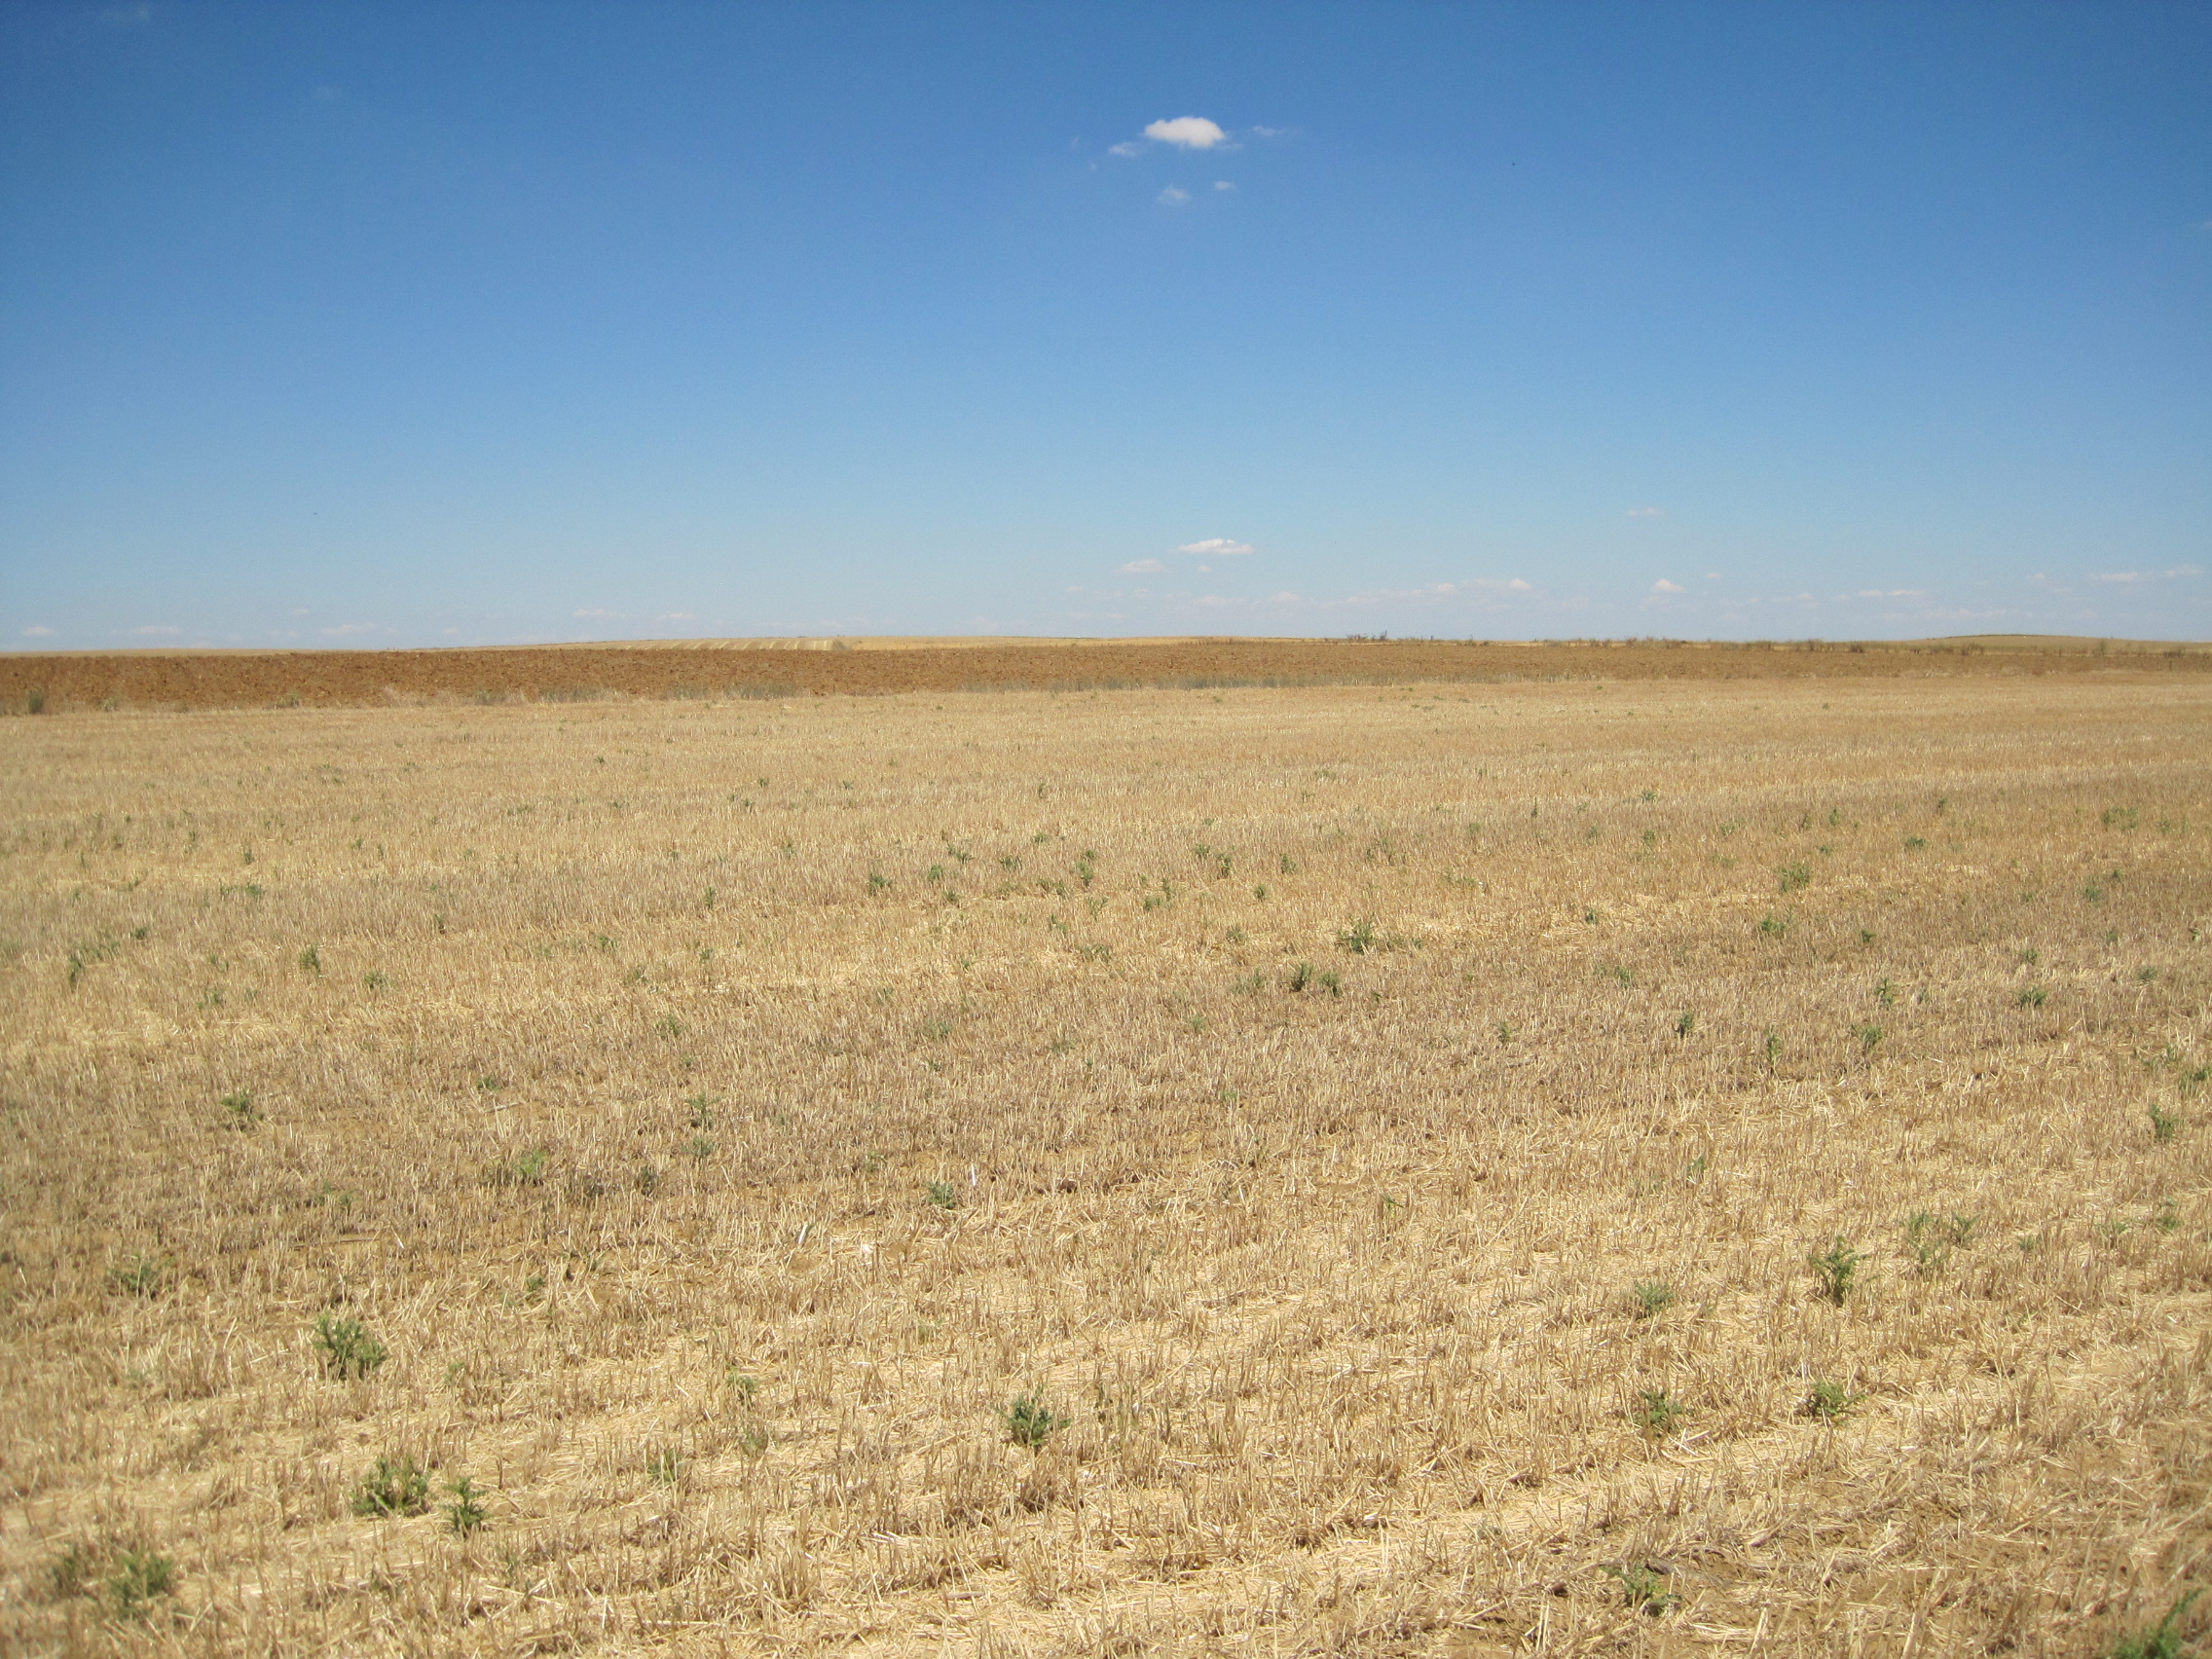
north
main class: Cropland
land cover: Barley
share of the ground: < 10 %
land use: Agriculture (excluding fallow land and kitchen gardens)
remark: Harvested field
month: July
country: ES
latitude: 42.0965
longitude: -4.8892
